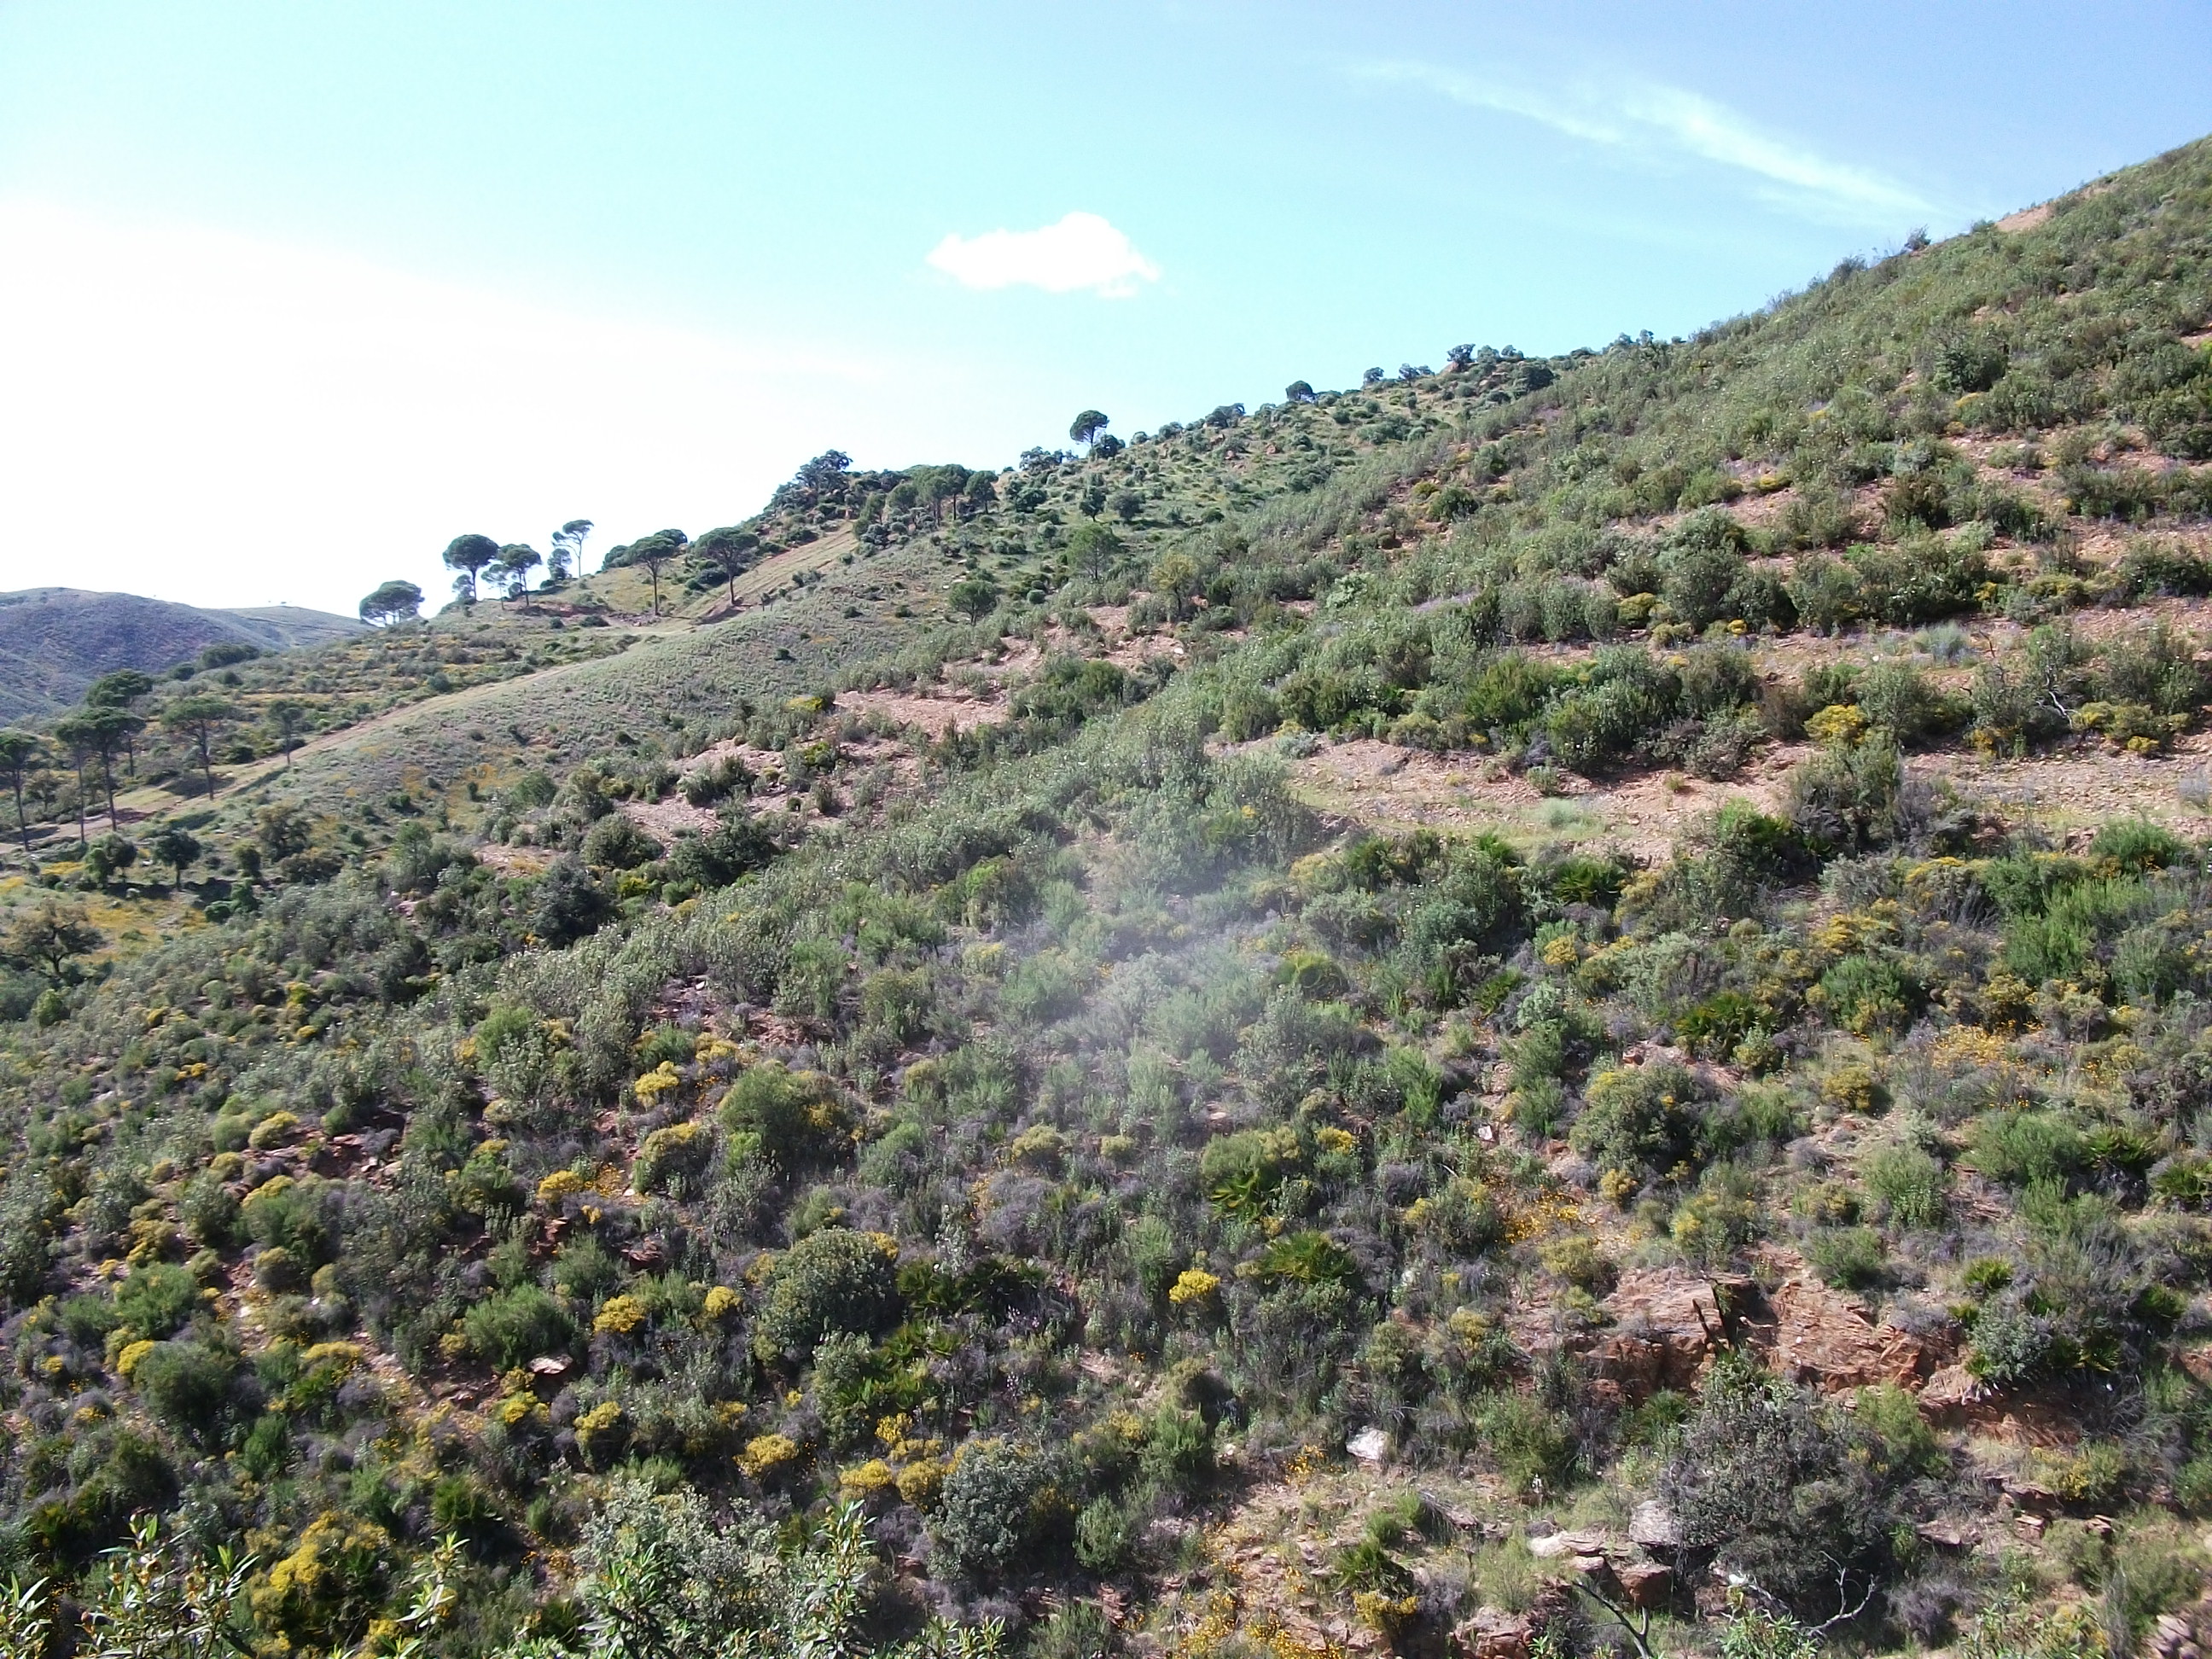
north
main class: Shrubland
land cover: Shrubland without tree cover
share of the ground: > 75 %
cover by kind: shrubs 100 %
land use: Semi-natural and natural areas not in use
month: April
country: ES
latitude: 37.6380
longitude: -6.5265
